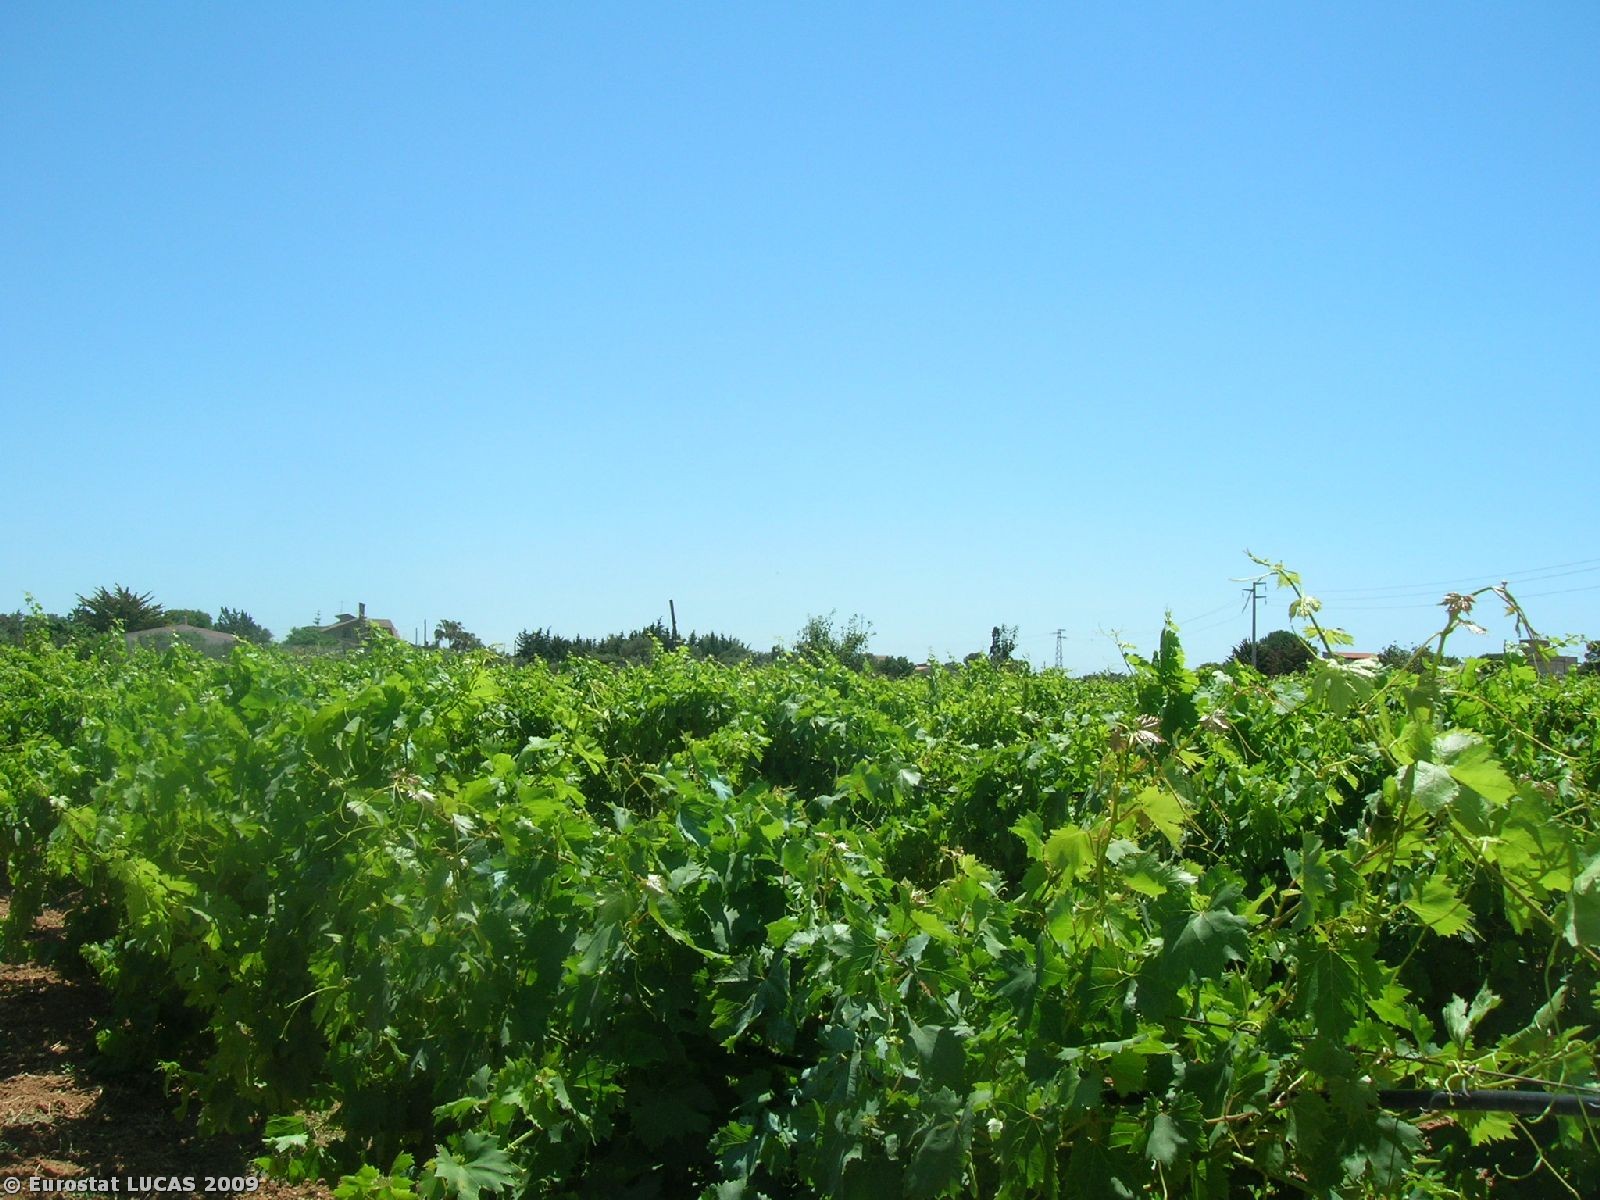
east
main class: Cropland
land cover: Vineyards
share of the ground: 50 - 75 %
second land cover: Bare land
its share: > 75 %
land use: Agriculture (excluding fallow land and kitchen gardens)
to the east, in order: Vineyards; Bare land; Artificial constructions; Permanent crops (only in case pi); Bare land; Artificial constructions in urban areas; Permanent crops (only in case pi); Bare land; Artificial constructions in urban areas; Permanent crops (only in case pi); Bare land
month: June
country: IT
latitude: 37.6570
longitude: 12.6212
